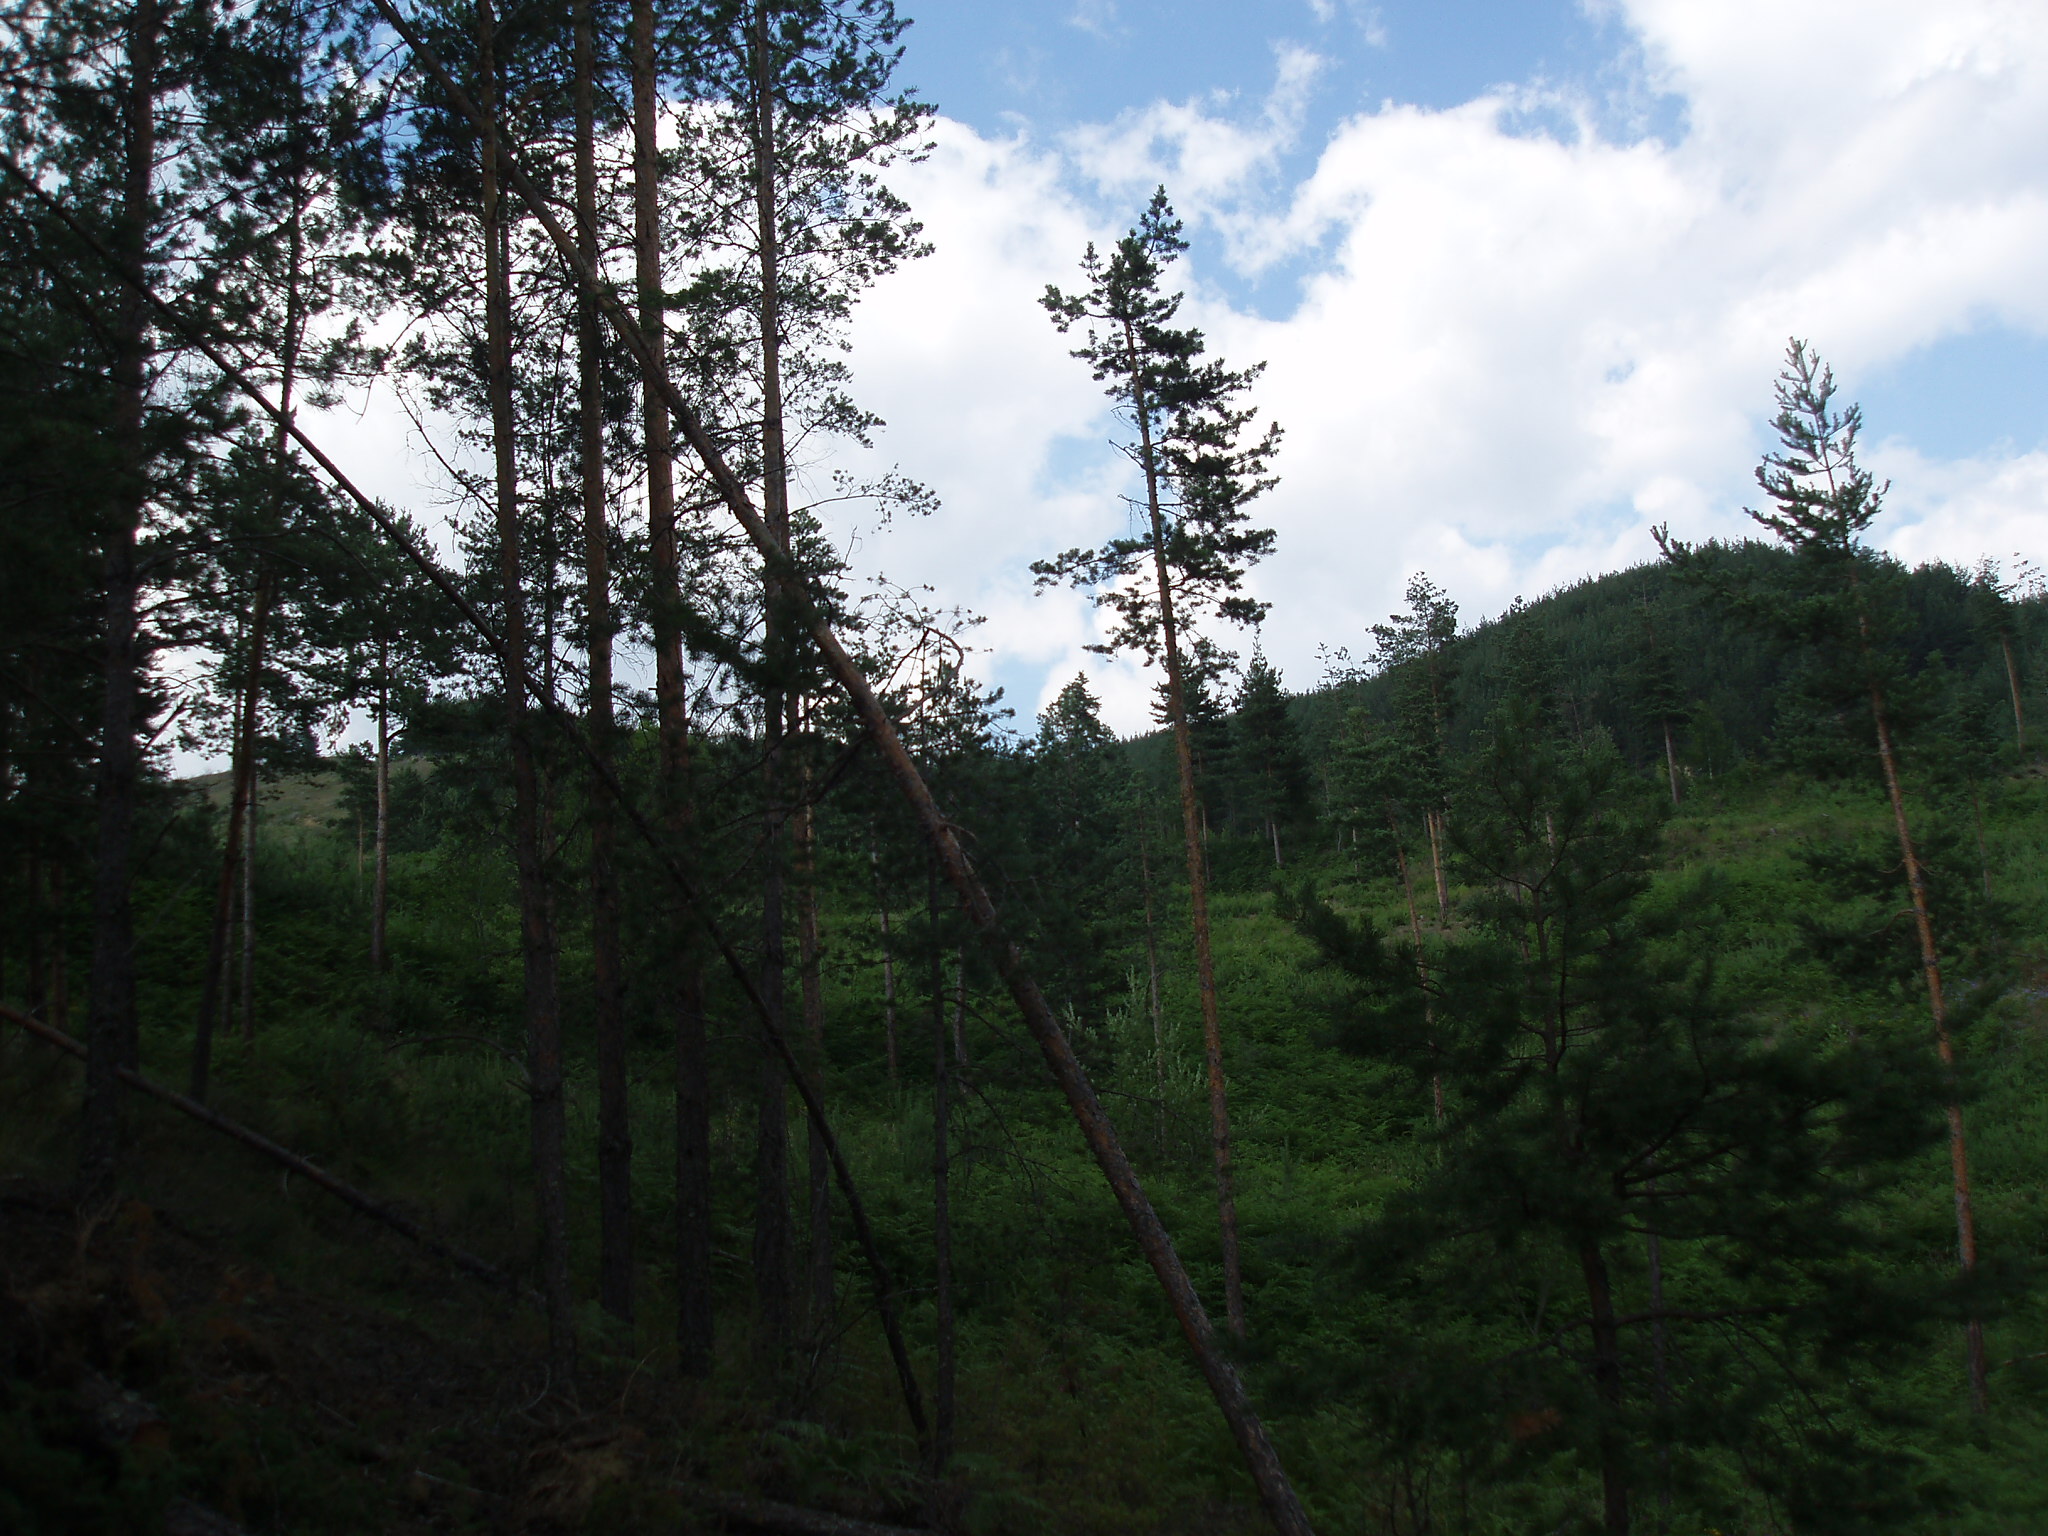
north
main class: Woodland
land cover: Pine dominated coniferous woodland
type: hemiboreal forest and nemoral coniferous forest and mixed broadleaved-coniferous forest
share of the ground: > 75 %
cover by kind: coniferous forest trees 90 %, unconsolidated bare surface 10 %
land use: Forestry
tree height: > 5 m
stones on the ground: 10 - 25 %
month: July
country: BG
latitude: 41.9641
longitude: 23.5071
